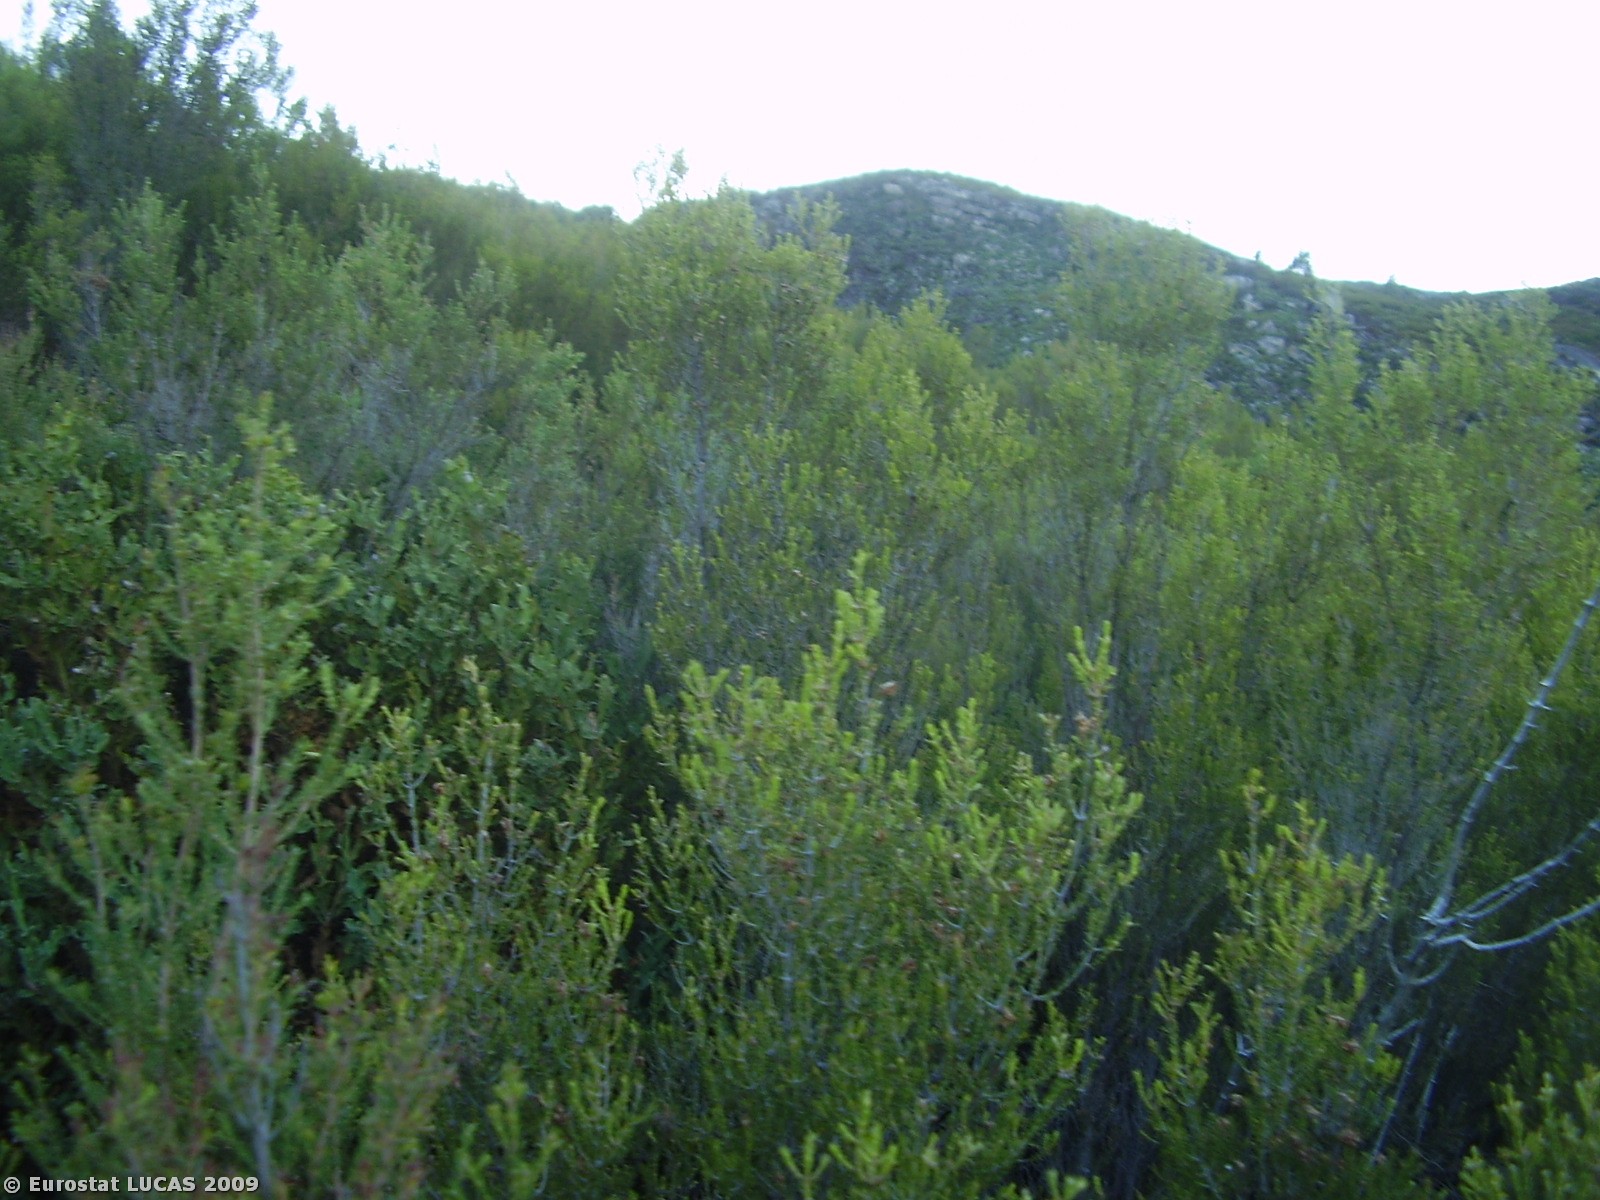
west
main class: Shrubland
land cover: Shrubland without tree cover
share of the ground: > 75 %
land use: Fallow land
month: September
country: PT
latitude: 41.7563
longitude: -7.6341
